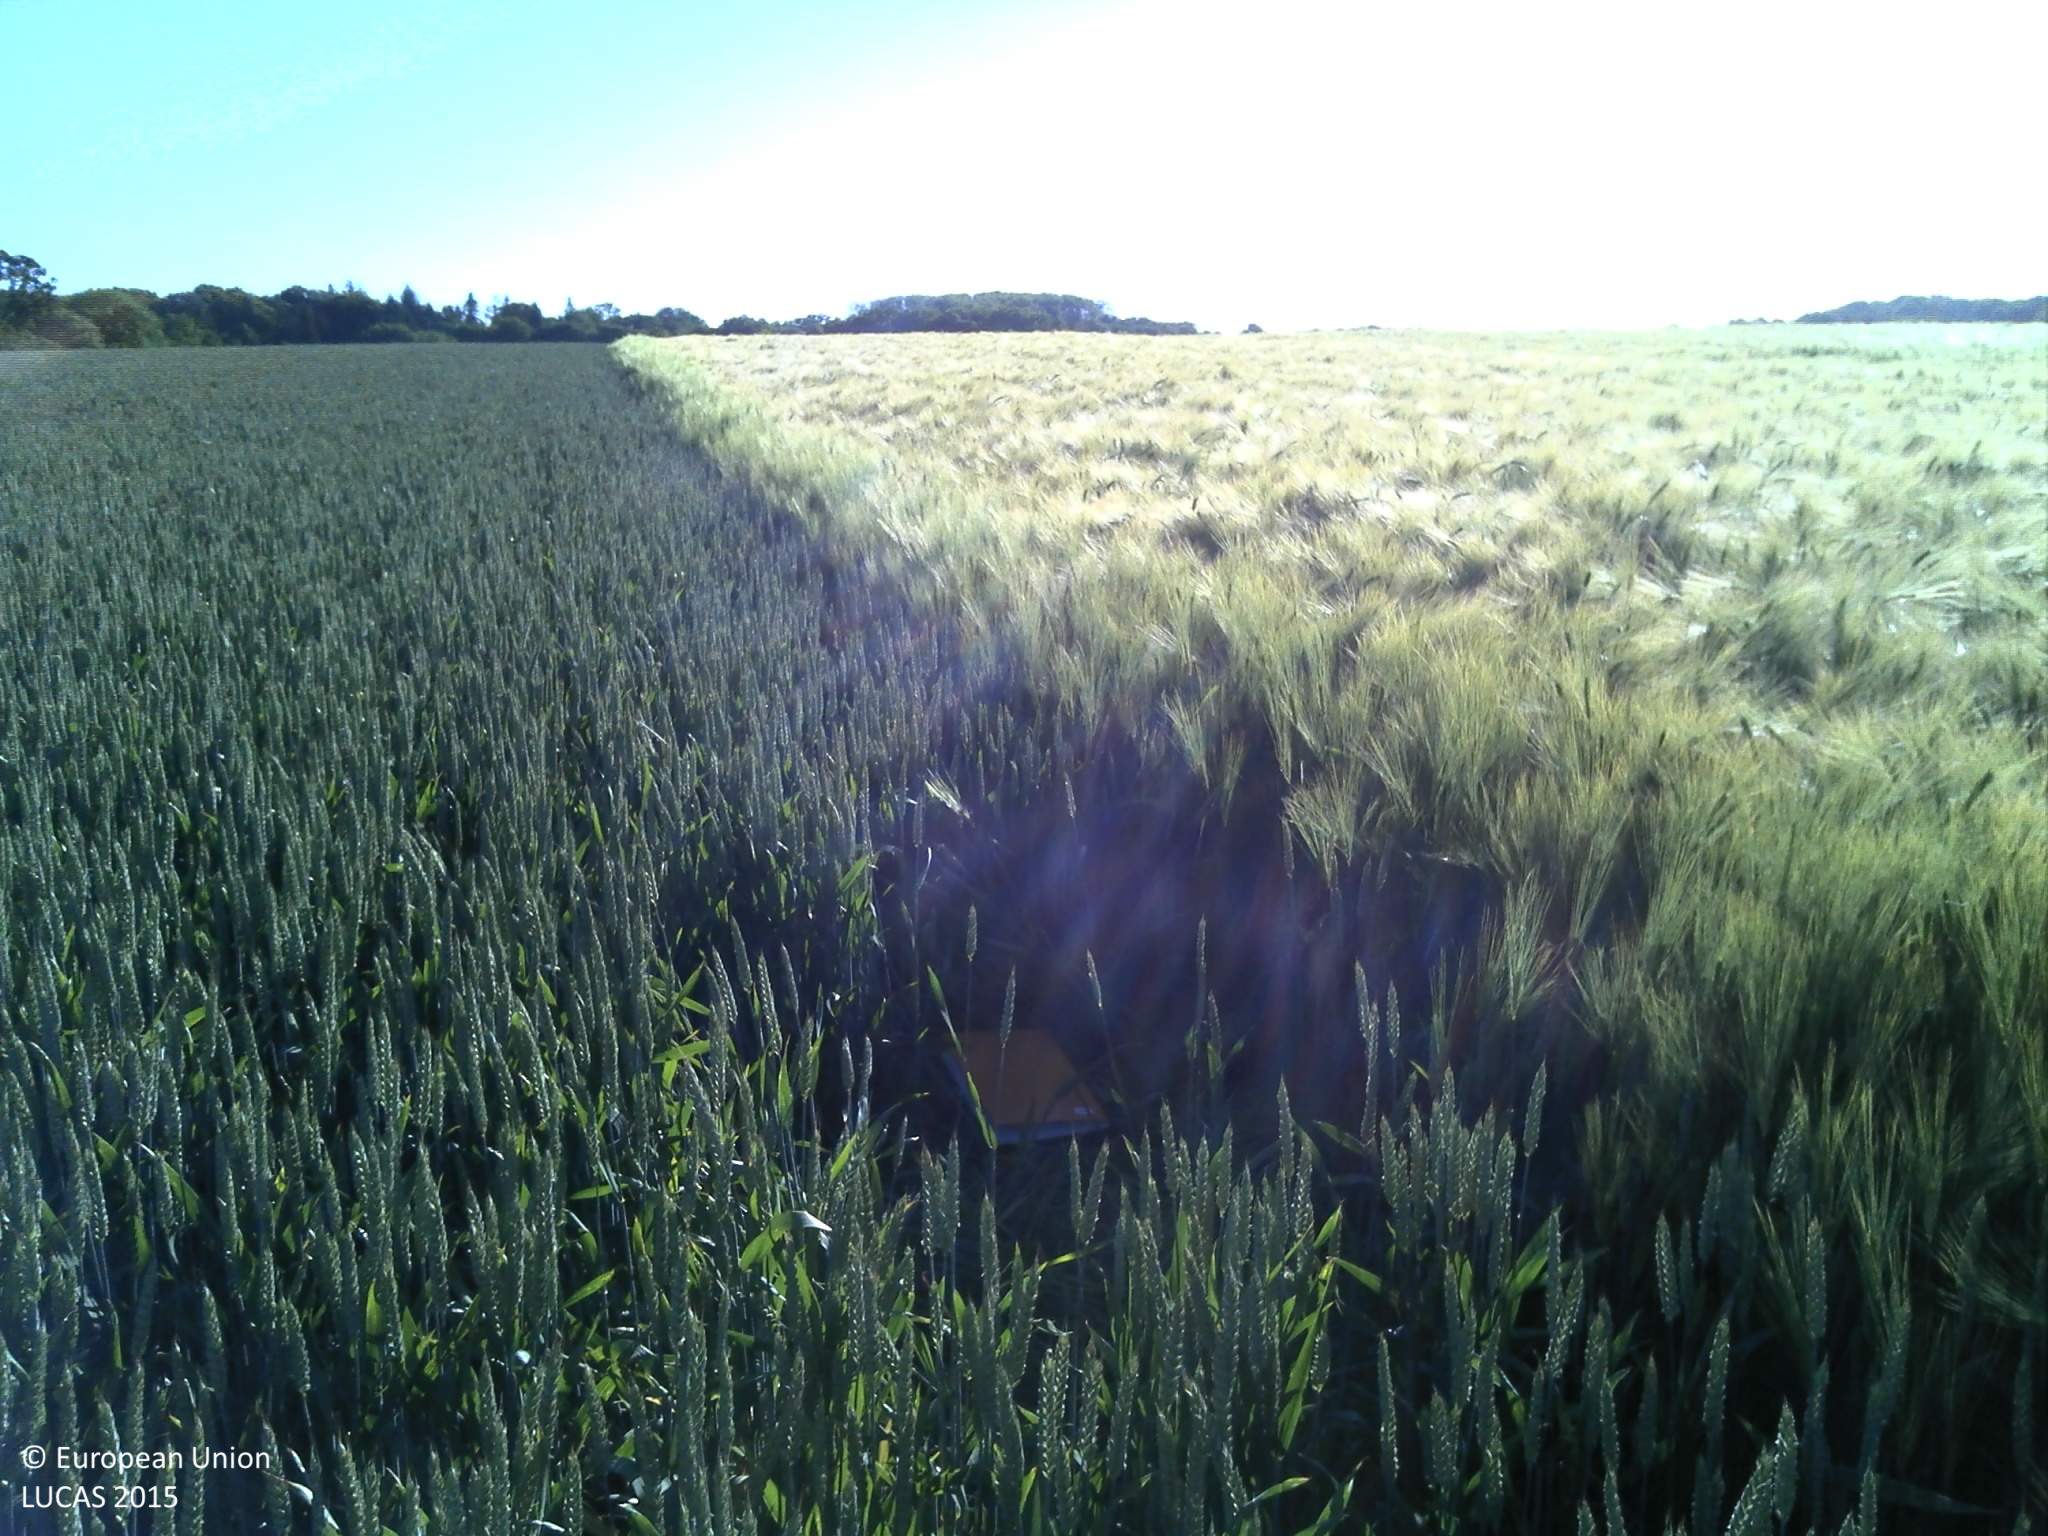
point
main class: Cropland
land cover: Common wheat
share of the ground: > 75 %
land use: Agriculture (excluding fallow land and kitchen gardens)
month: June
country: FR
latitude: 49.6102
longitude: 0.9959
